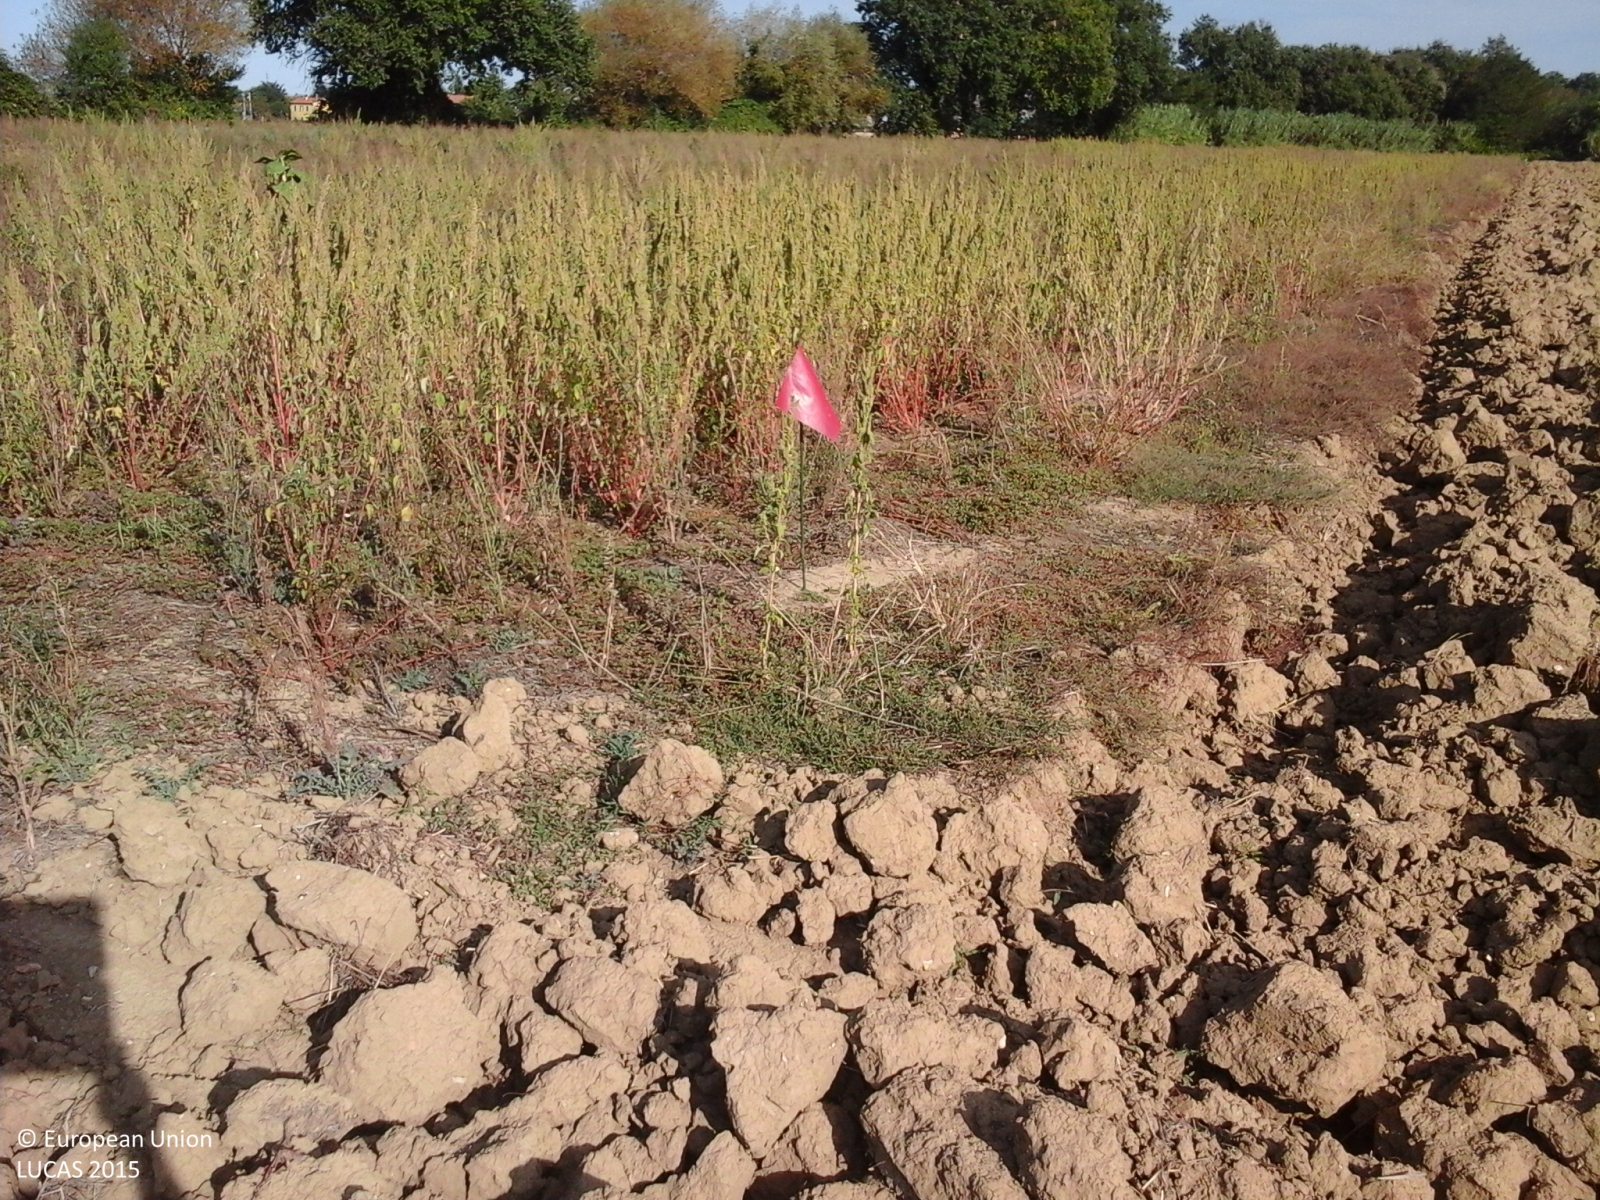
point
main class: Grassland
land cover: Spontaneously vegetated surfaces
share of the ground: > 75 %
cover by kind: herbaceous plants 100 %
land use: Fallow land
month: September
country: IT
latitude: 43.7675
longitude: 12.9371
